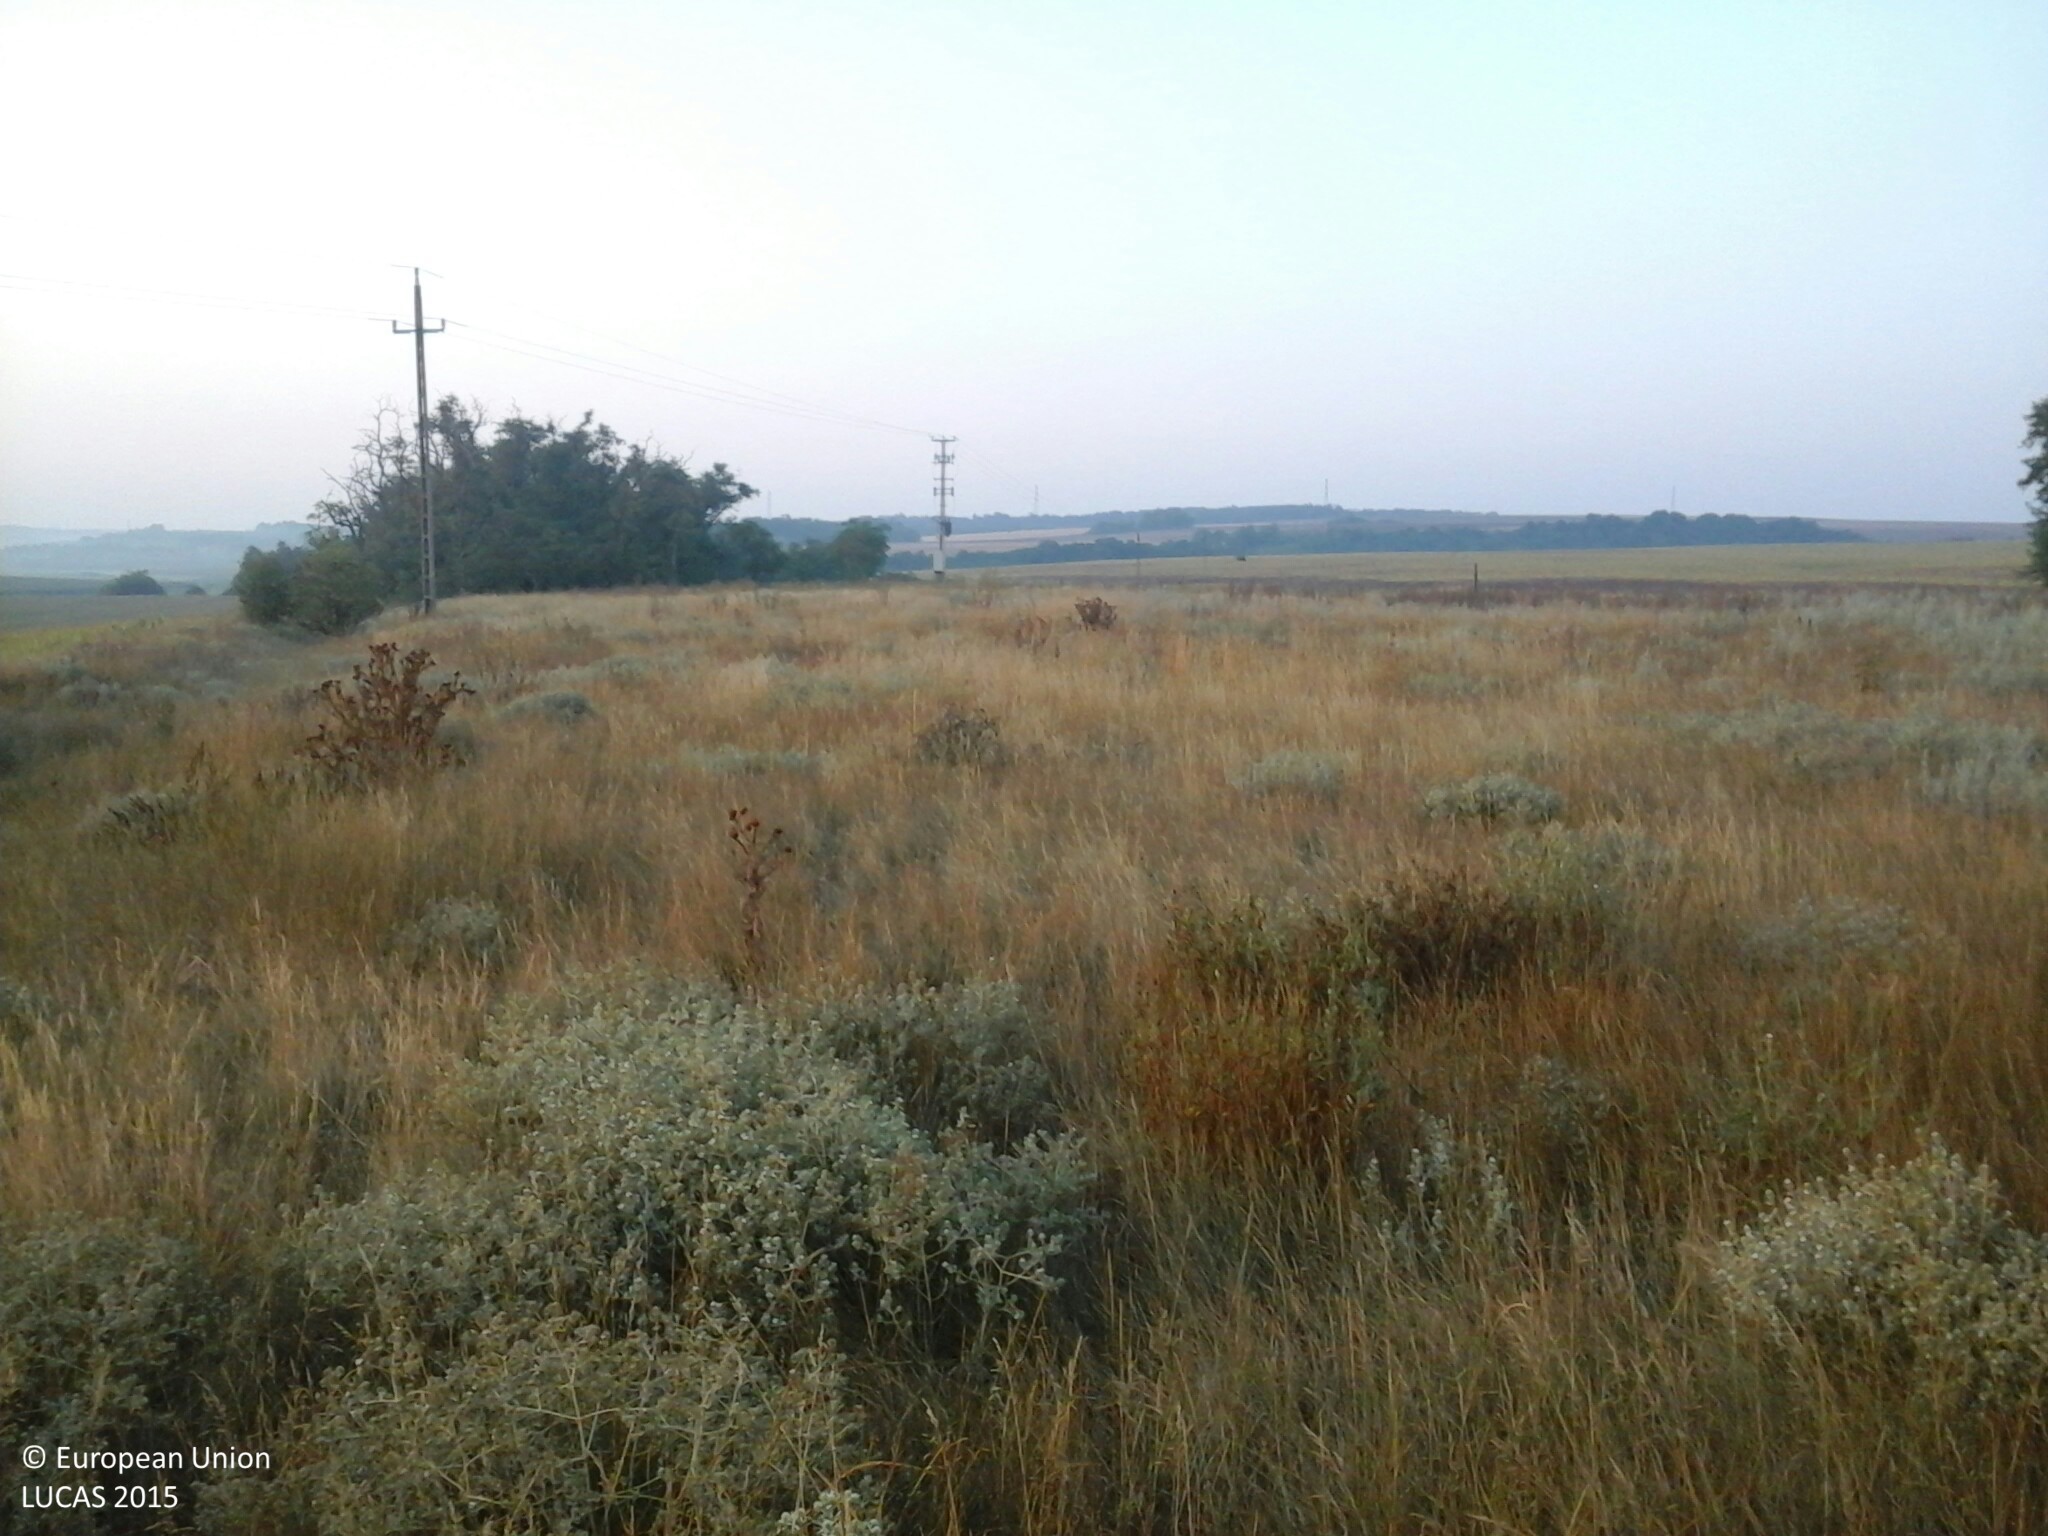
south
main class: Grassland
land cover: Grassland without tree/shrub cover
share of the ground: > 75 %
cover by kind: herbaceous plants 100 %
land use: Semi-natural and natural areas not in use
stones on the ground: < 10 %
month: August
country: HU
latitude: 47.4214
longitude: 18.5371
